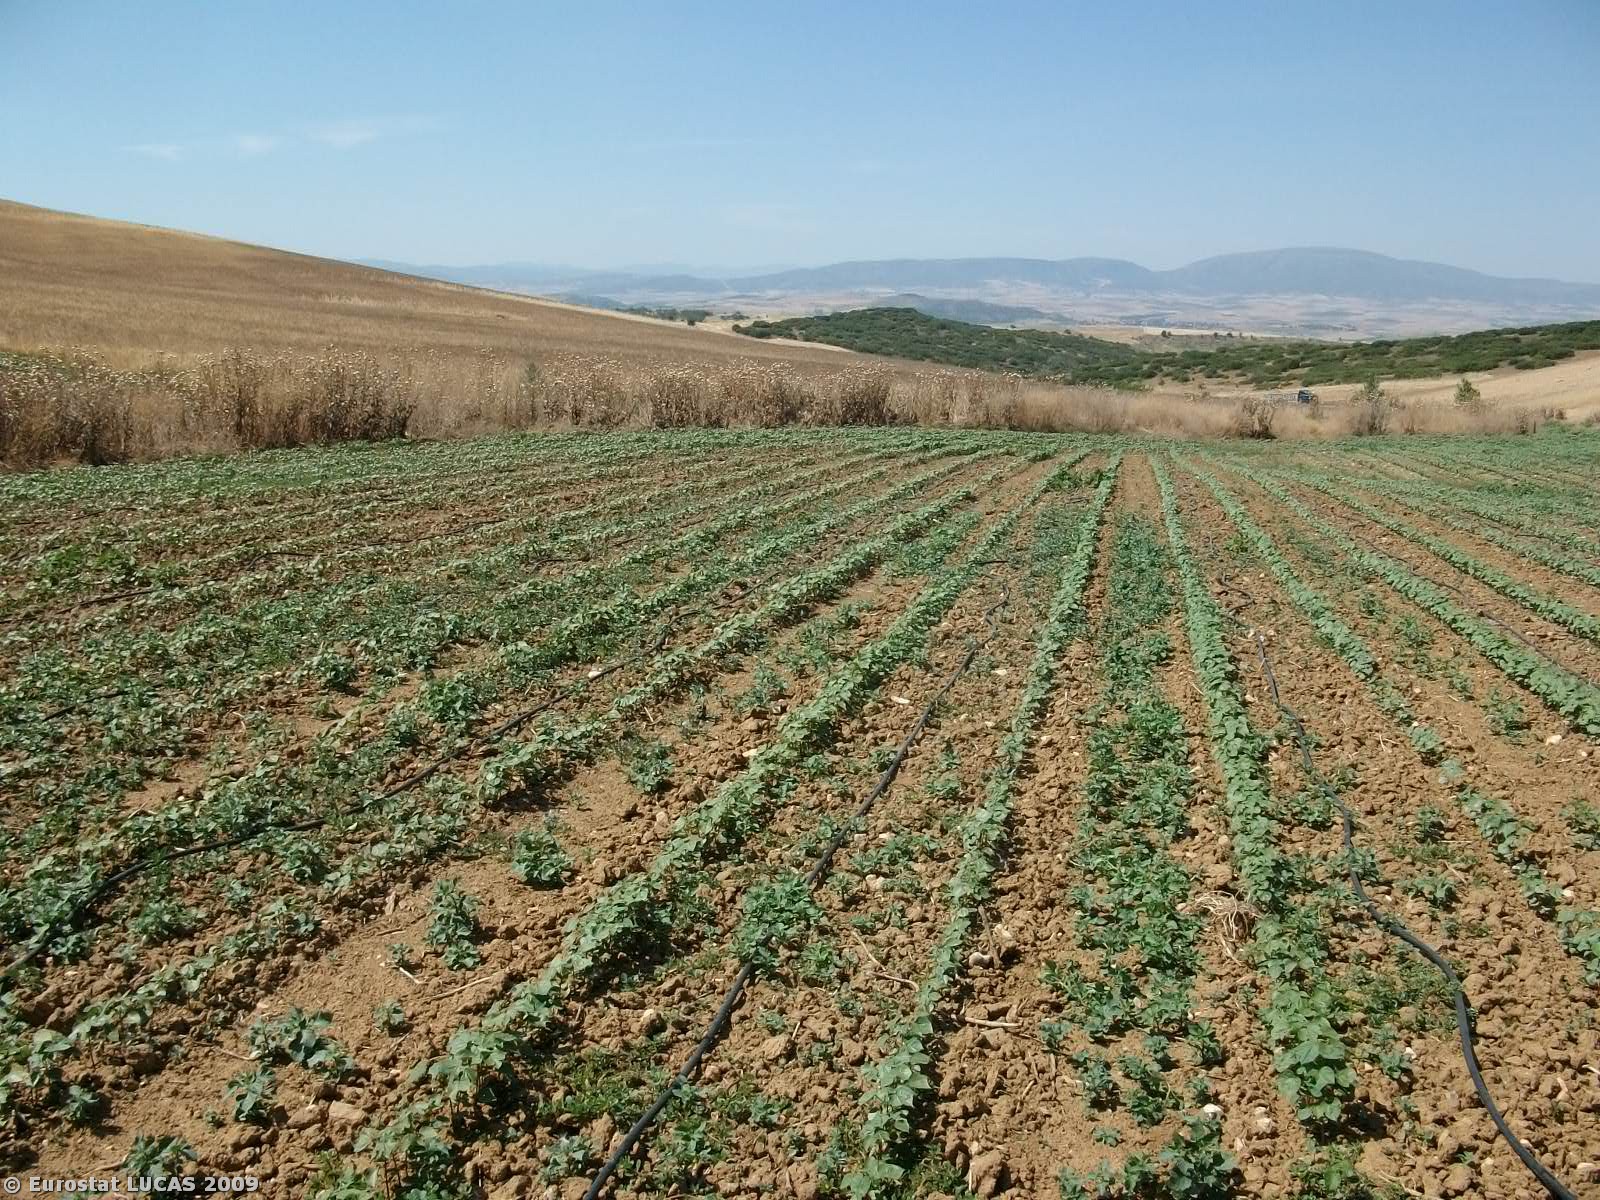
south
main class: Cropland
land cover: Cotton
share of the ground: 10 - 25 %
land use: Agriculture (excluding fallow land and kitchen gardens)
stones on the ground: 10 - 25 %
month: April
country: GR
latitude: 39.3685
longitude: 22.5348
